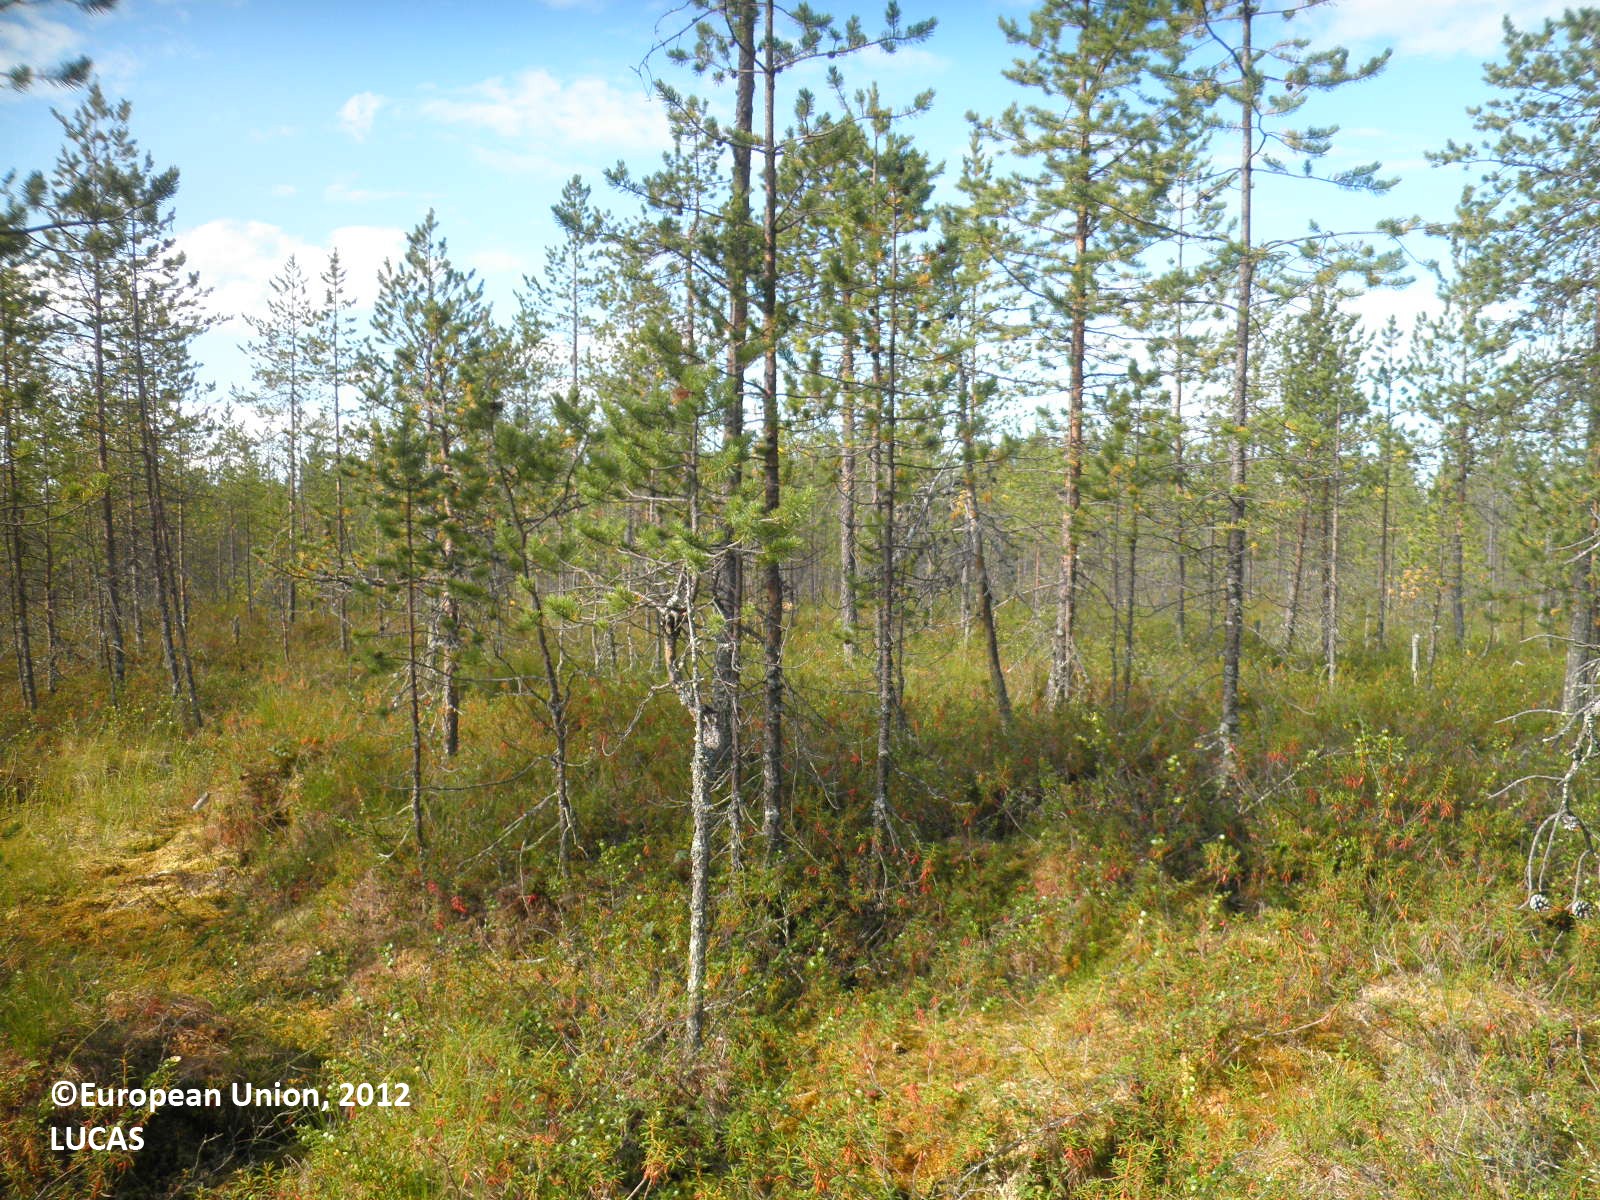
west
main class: Woodland
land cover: Pine dominated coniferous woodland
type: boreal forest
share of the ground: 25 - 50 %
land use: Forestry
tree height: > 5 m
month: August
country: FI
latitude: 67.4777
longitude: 26.9505
